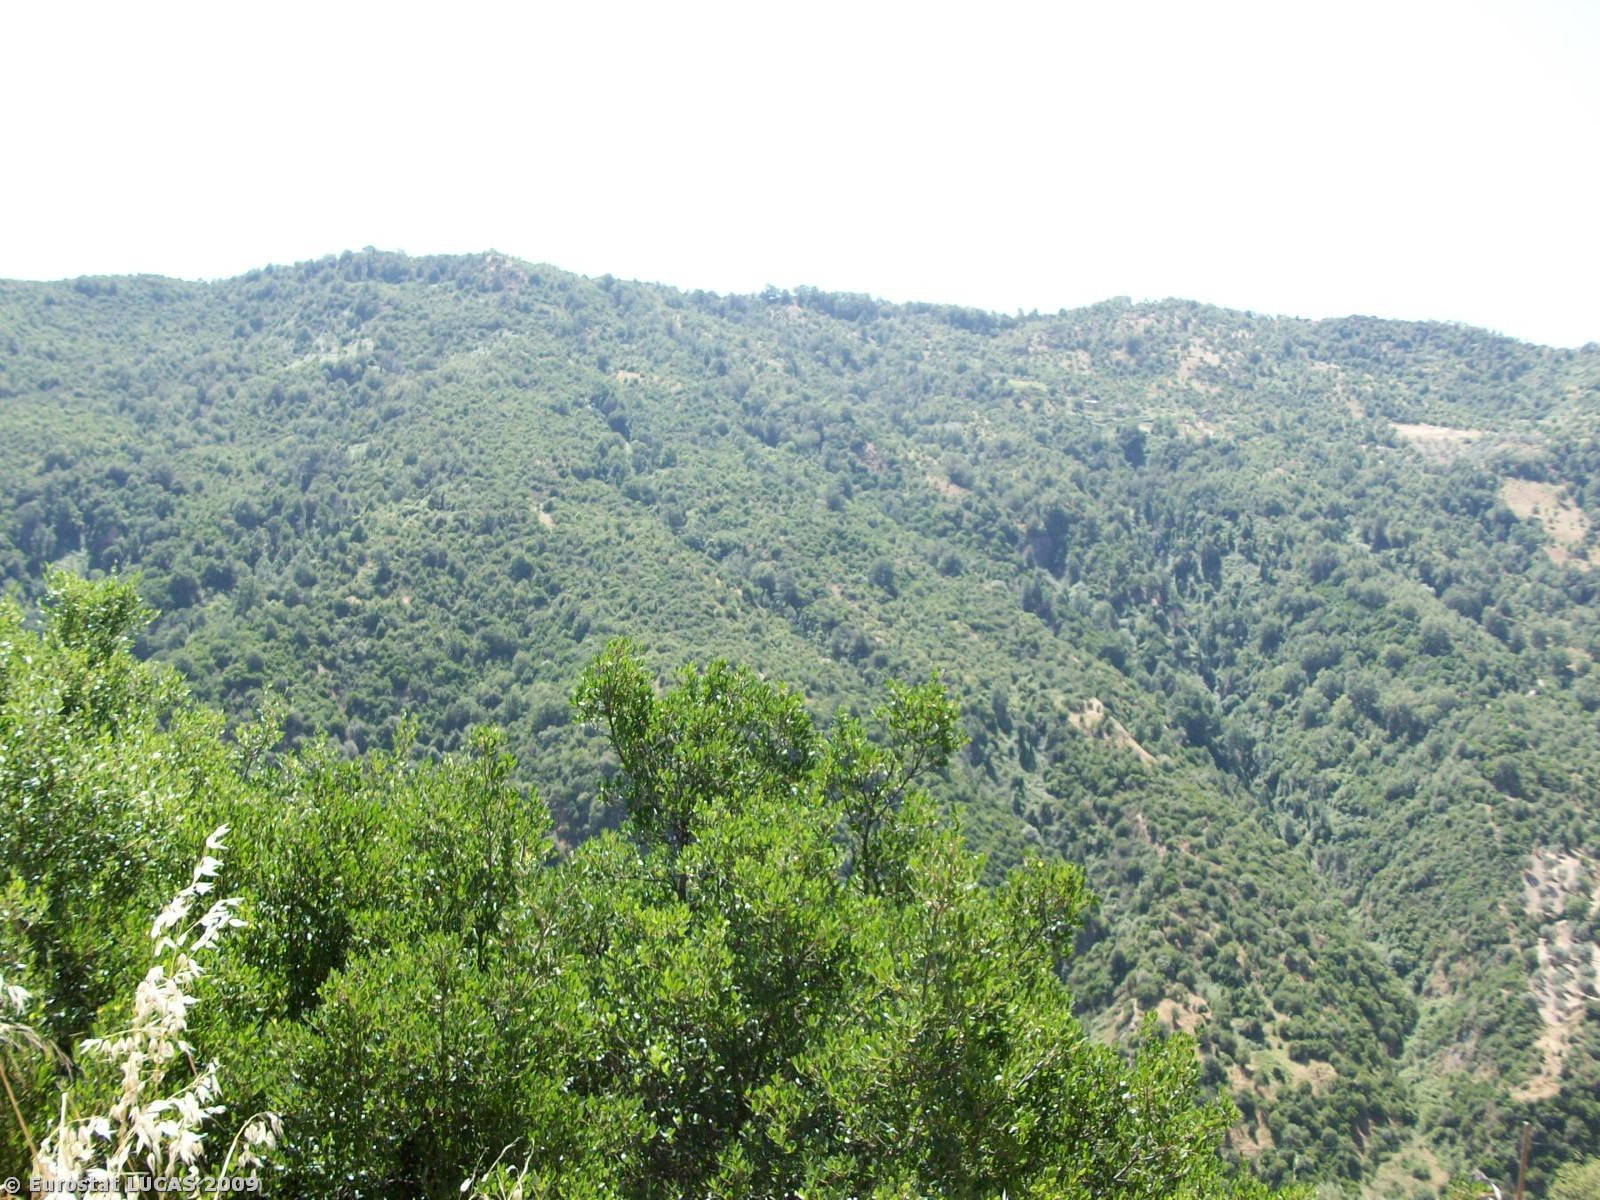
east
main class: Woodland
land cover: Broadleaved woodland
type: thermophilous deciduous forest
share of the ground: > 75 %
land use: Unused
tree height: > 5 m
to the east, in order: Broadleaved woodland
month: June
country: IT
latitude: 39.4915
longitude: 16.7252
